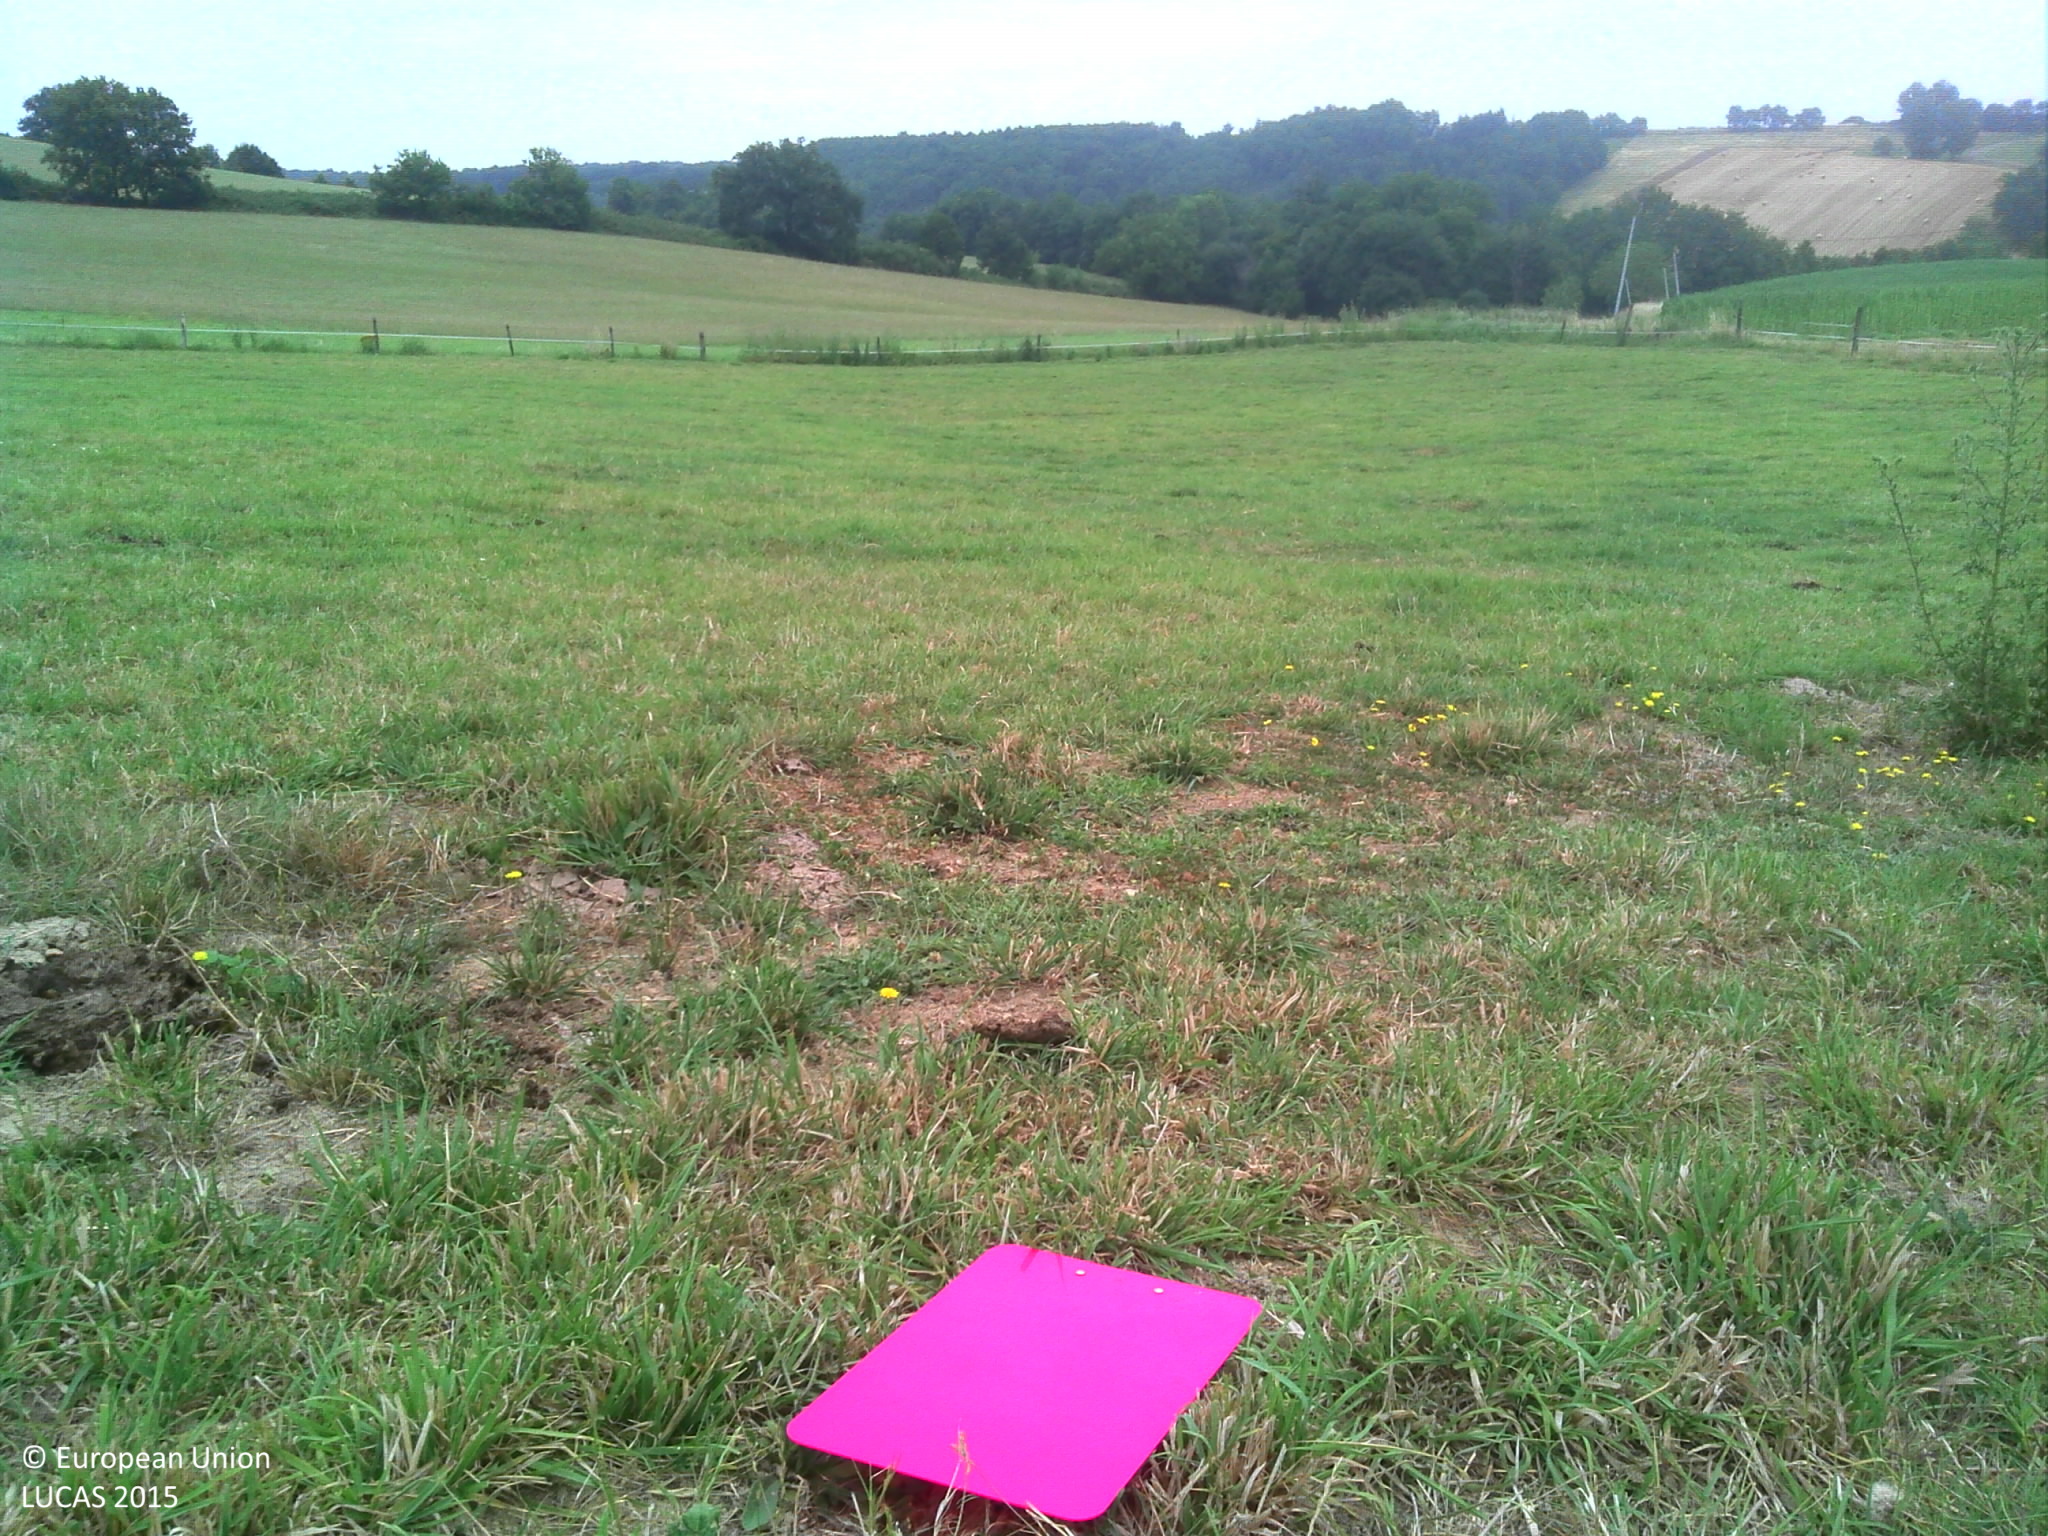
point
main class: Grassland
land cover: Grassland without tree/shrub cover
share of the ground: > 75 %
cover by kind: herbaceous plants 100 %
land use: Agriculture (excluding fallow land and kitchen gardens)
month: July
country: FR
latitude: 44.0250
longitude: 0.9274
